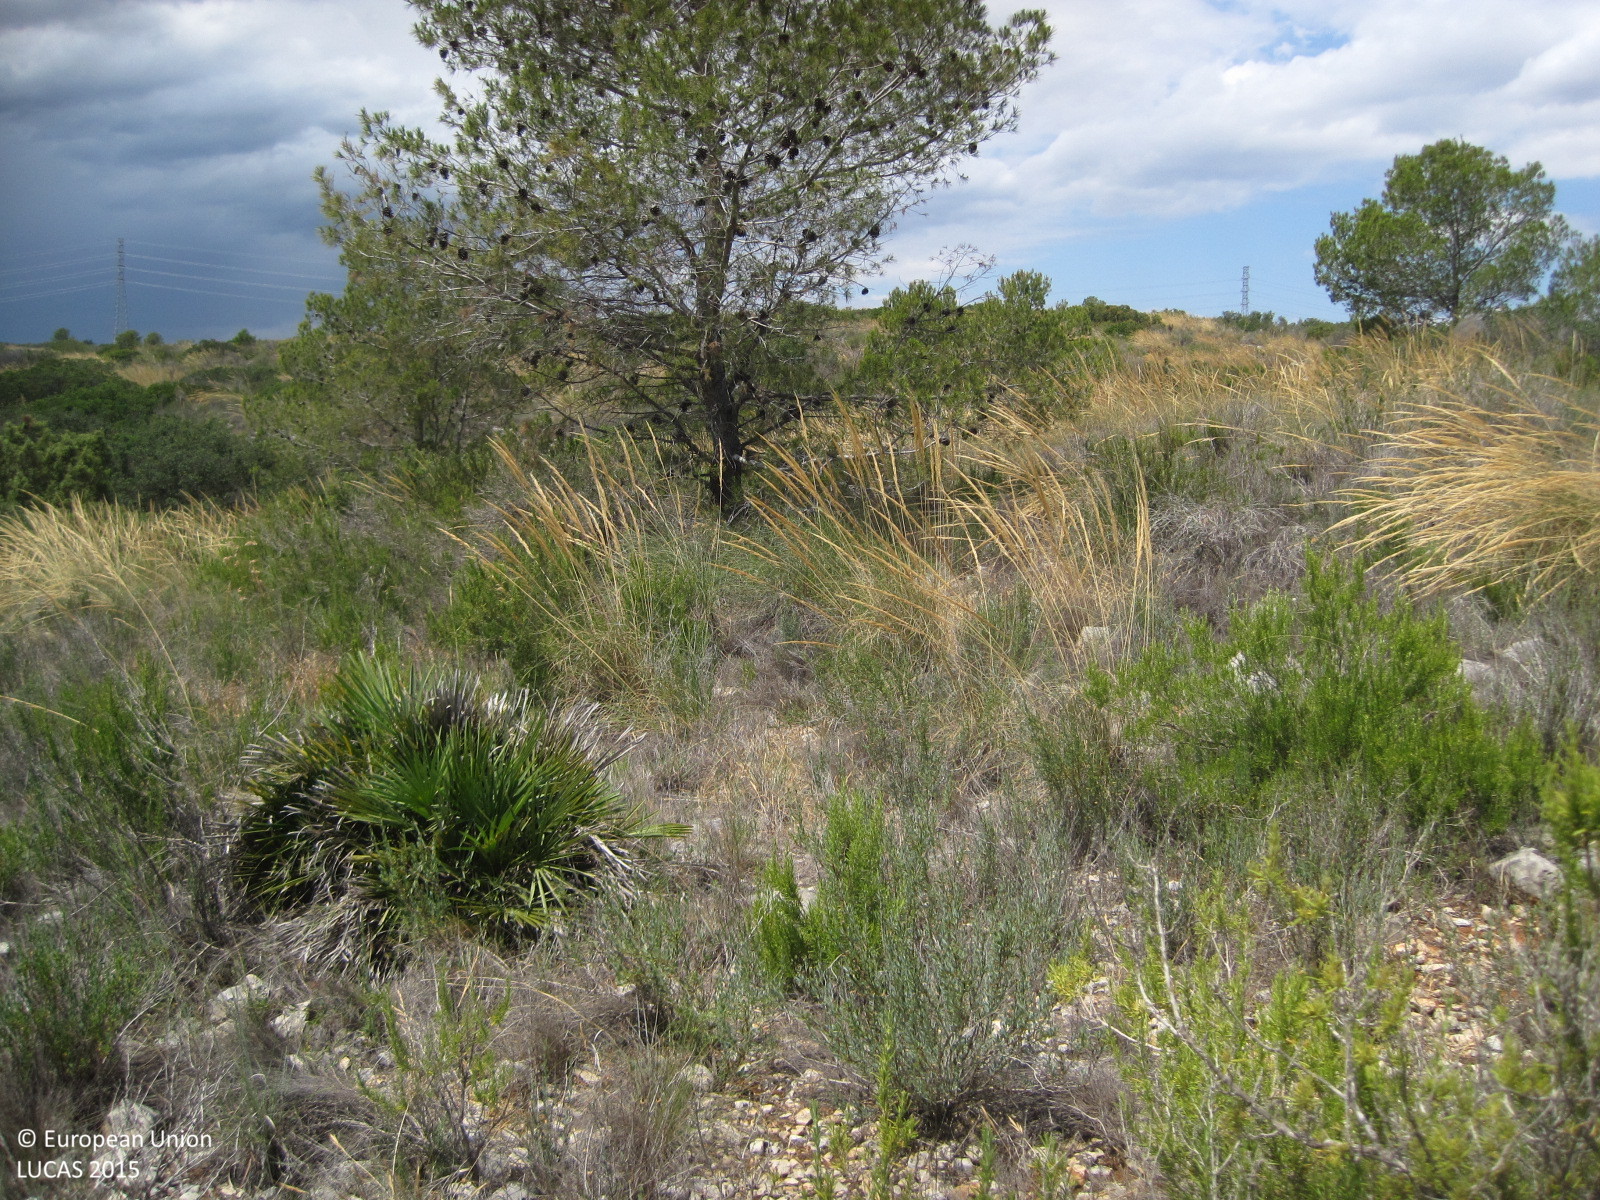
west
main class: Shrubland
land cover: Shrubland without tree cover
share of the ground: 25 - 50 %
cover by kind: shrubs 40 %, herbaceous plants 30 %, consolidated bare surface 30 %
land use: Semi-natural and natural areas not in use
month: June
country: ES
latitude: 39.2000
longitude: -0.5904
